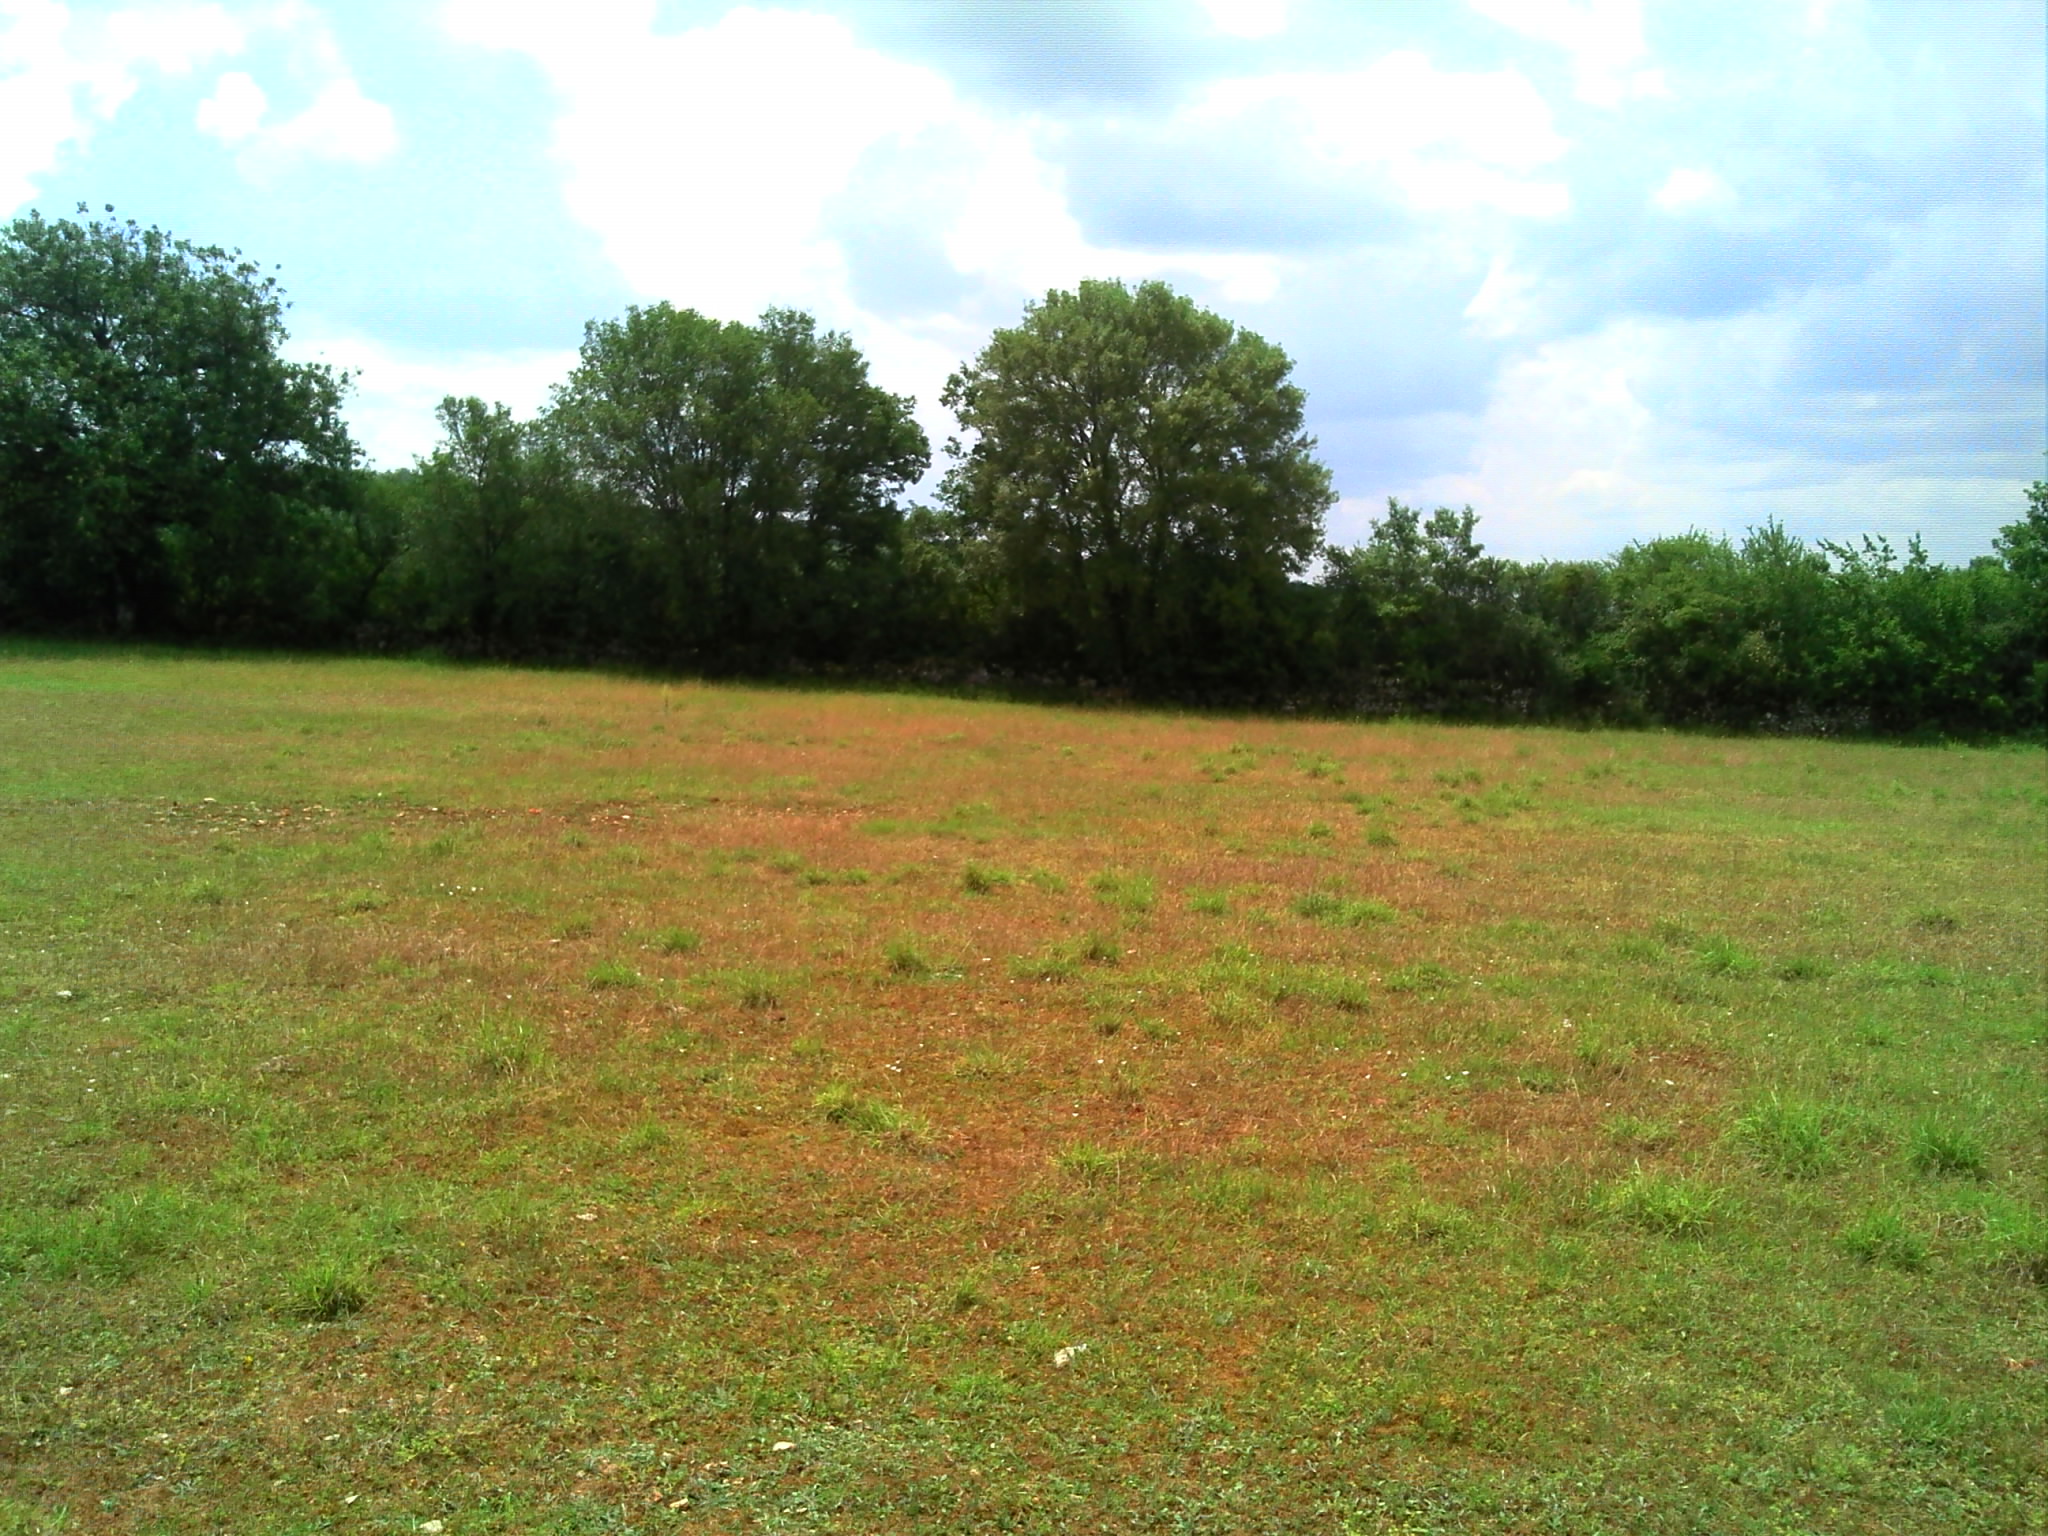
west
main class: Grassland
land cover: Spontaneously vegetated surfaces
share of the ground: > 75 %
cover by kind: herbaceous plants 95 %, shrubs 5 %
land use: Agriculture (excluding fallow land and kitchen gardens)
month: June
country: FR
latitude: 44.6052
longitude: 1.7968
